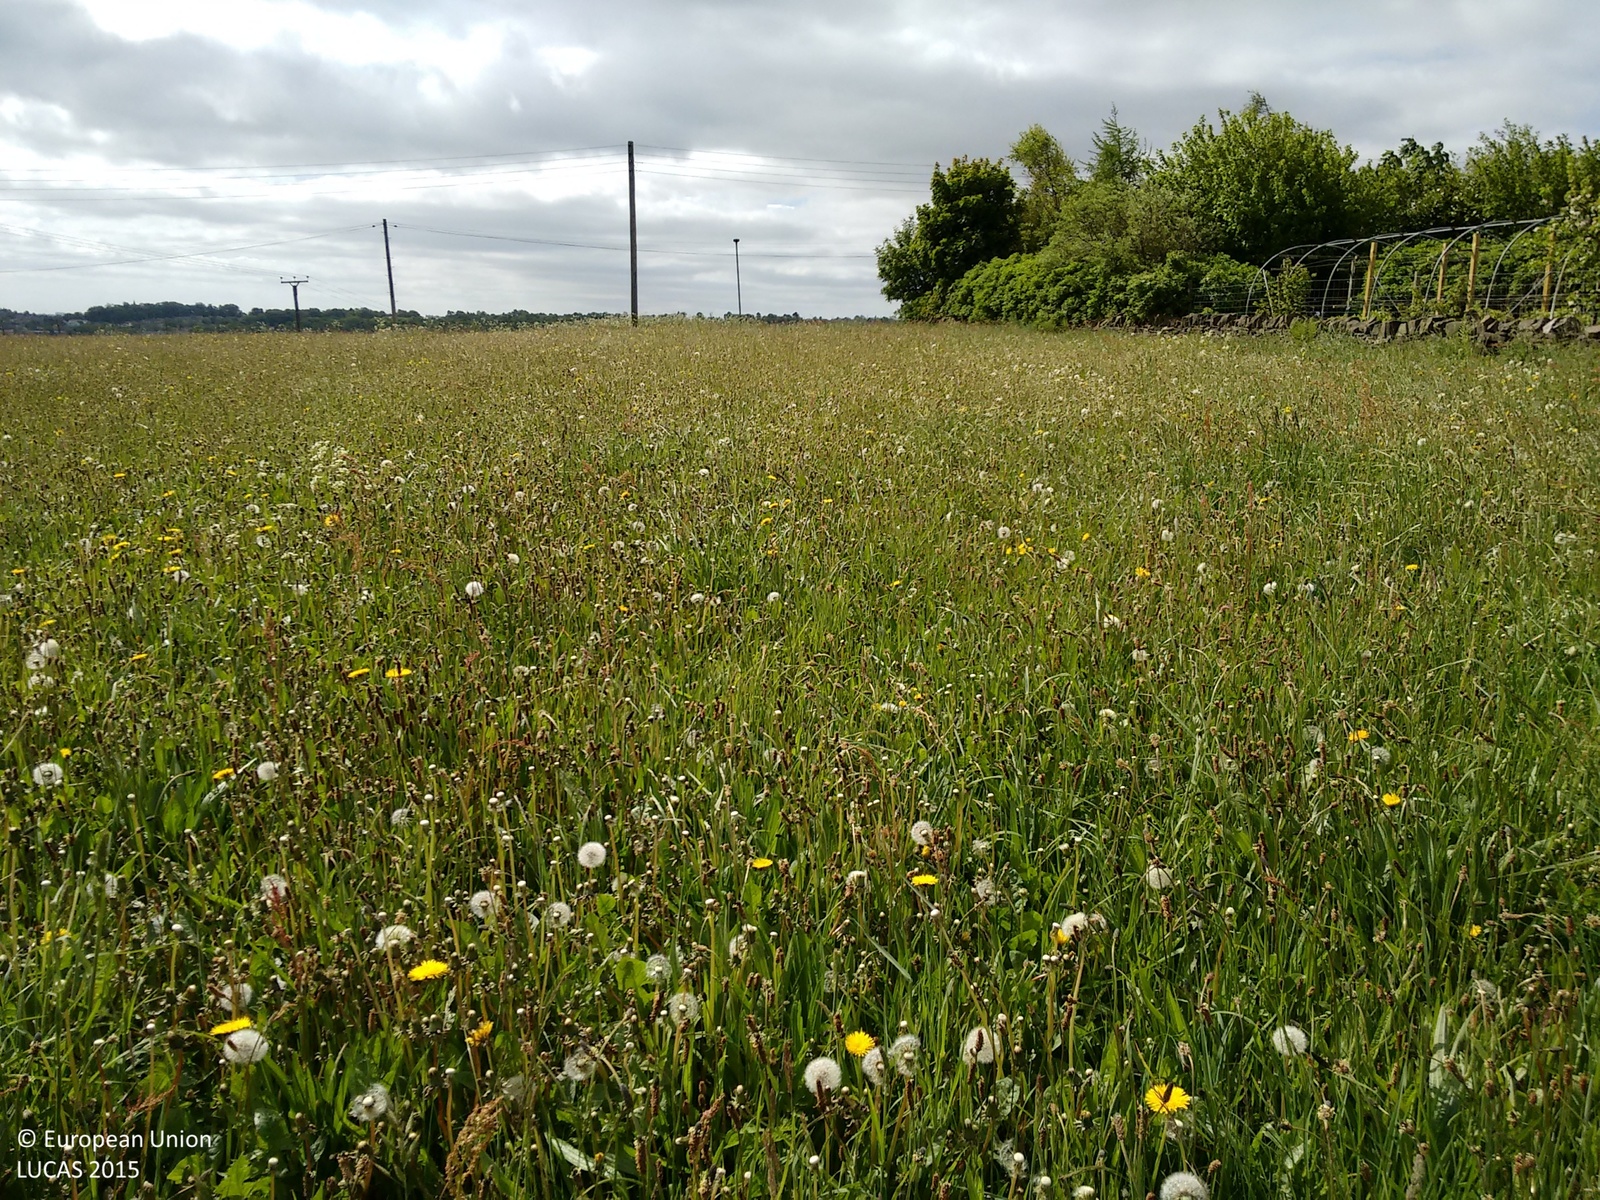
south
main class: Grassland
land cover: Grassland without tree/shrub cover
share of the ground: > 75 %
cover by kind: herbaceous plants 100 %
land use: Agriculture (excluding fallow land and kitchen gardens)
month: May
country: GB
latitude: 53.3918
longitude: -1.5544
